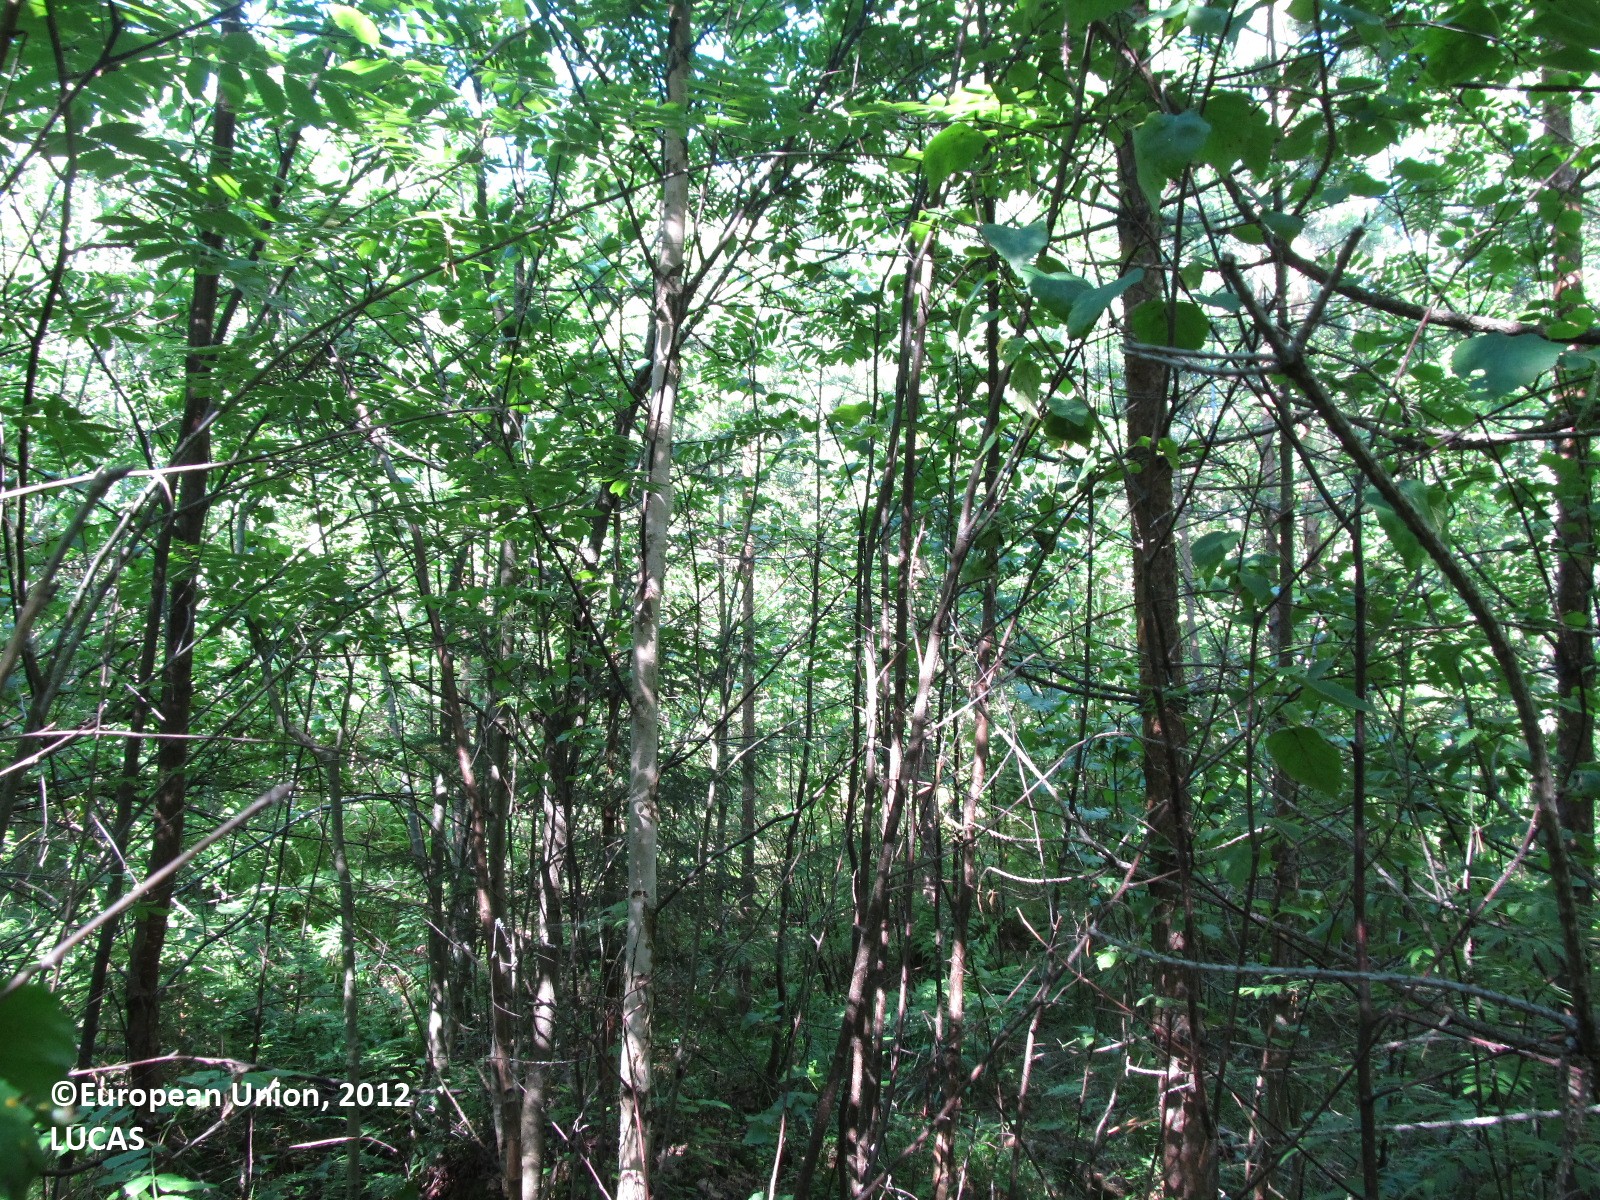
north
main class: Woodland
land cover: Broadleaved woodland
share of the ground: > 75 %
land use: Forestry
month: July
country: FI
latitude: 62.2091
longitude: 29.2469
